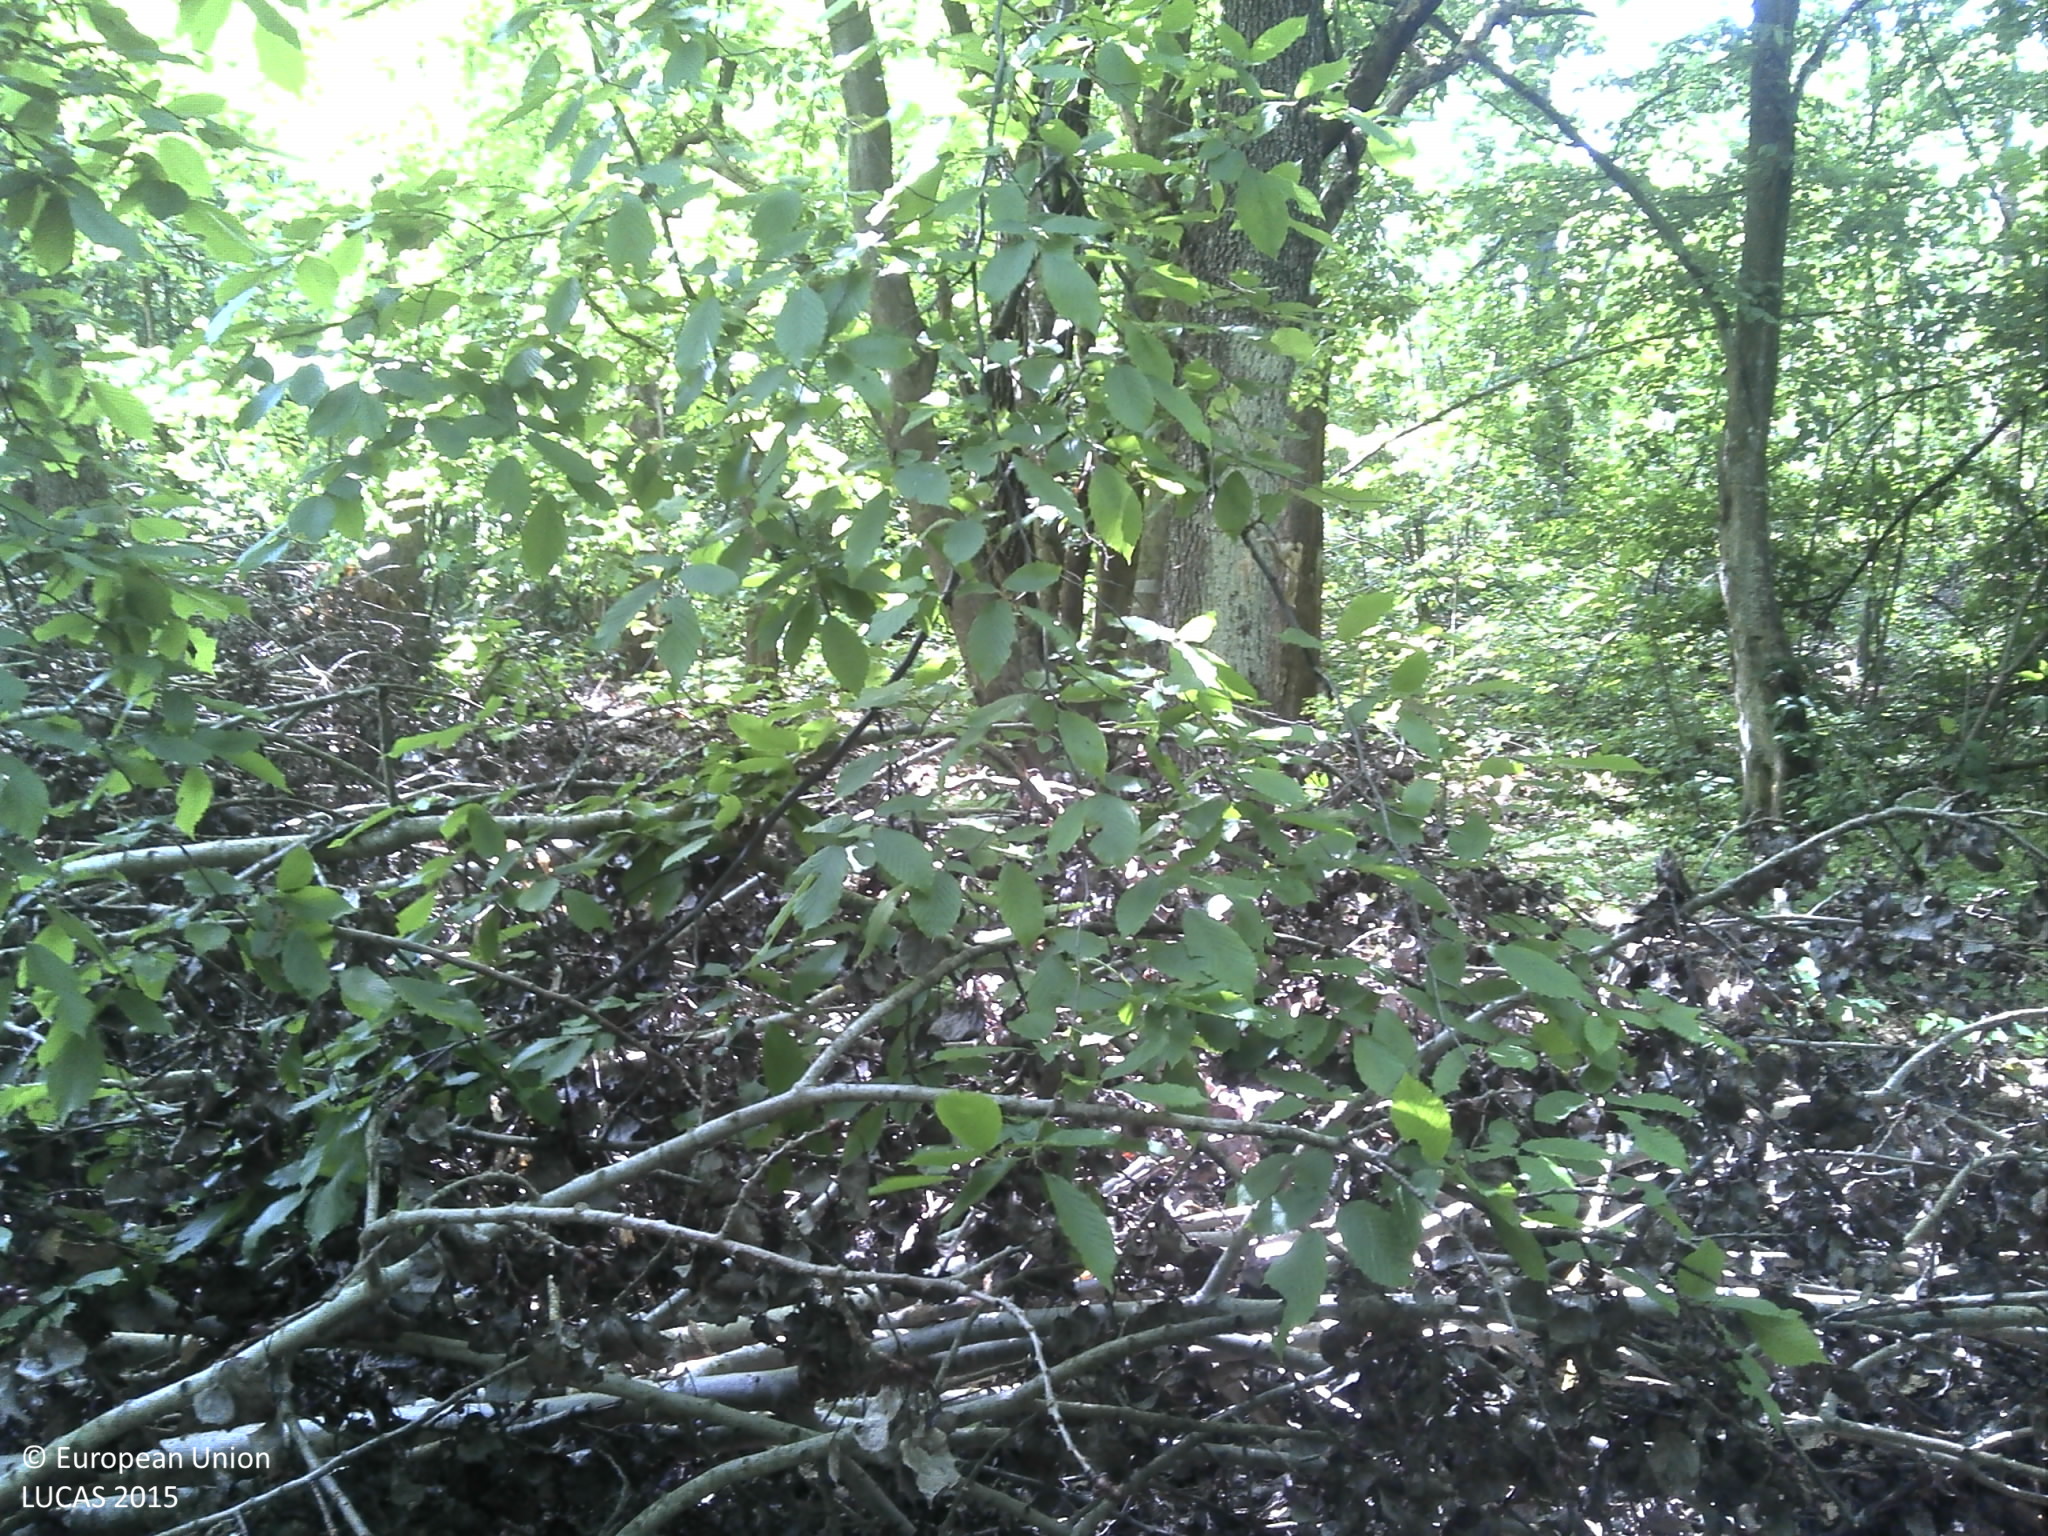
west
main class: Woodland
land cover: Broadleaved woodland
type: acidophilous oak and oak-birch forest
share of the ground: > 75 %
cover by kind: broadleaved forest trees 100 %
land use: Forestry
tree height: > 5 m
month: May
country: HR
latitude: 45.3690
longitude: 18.1628
